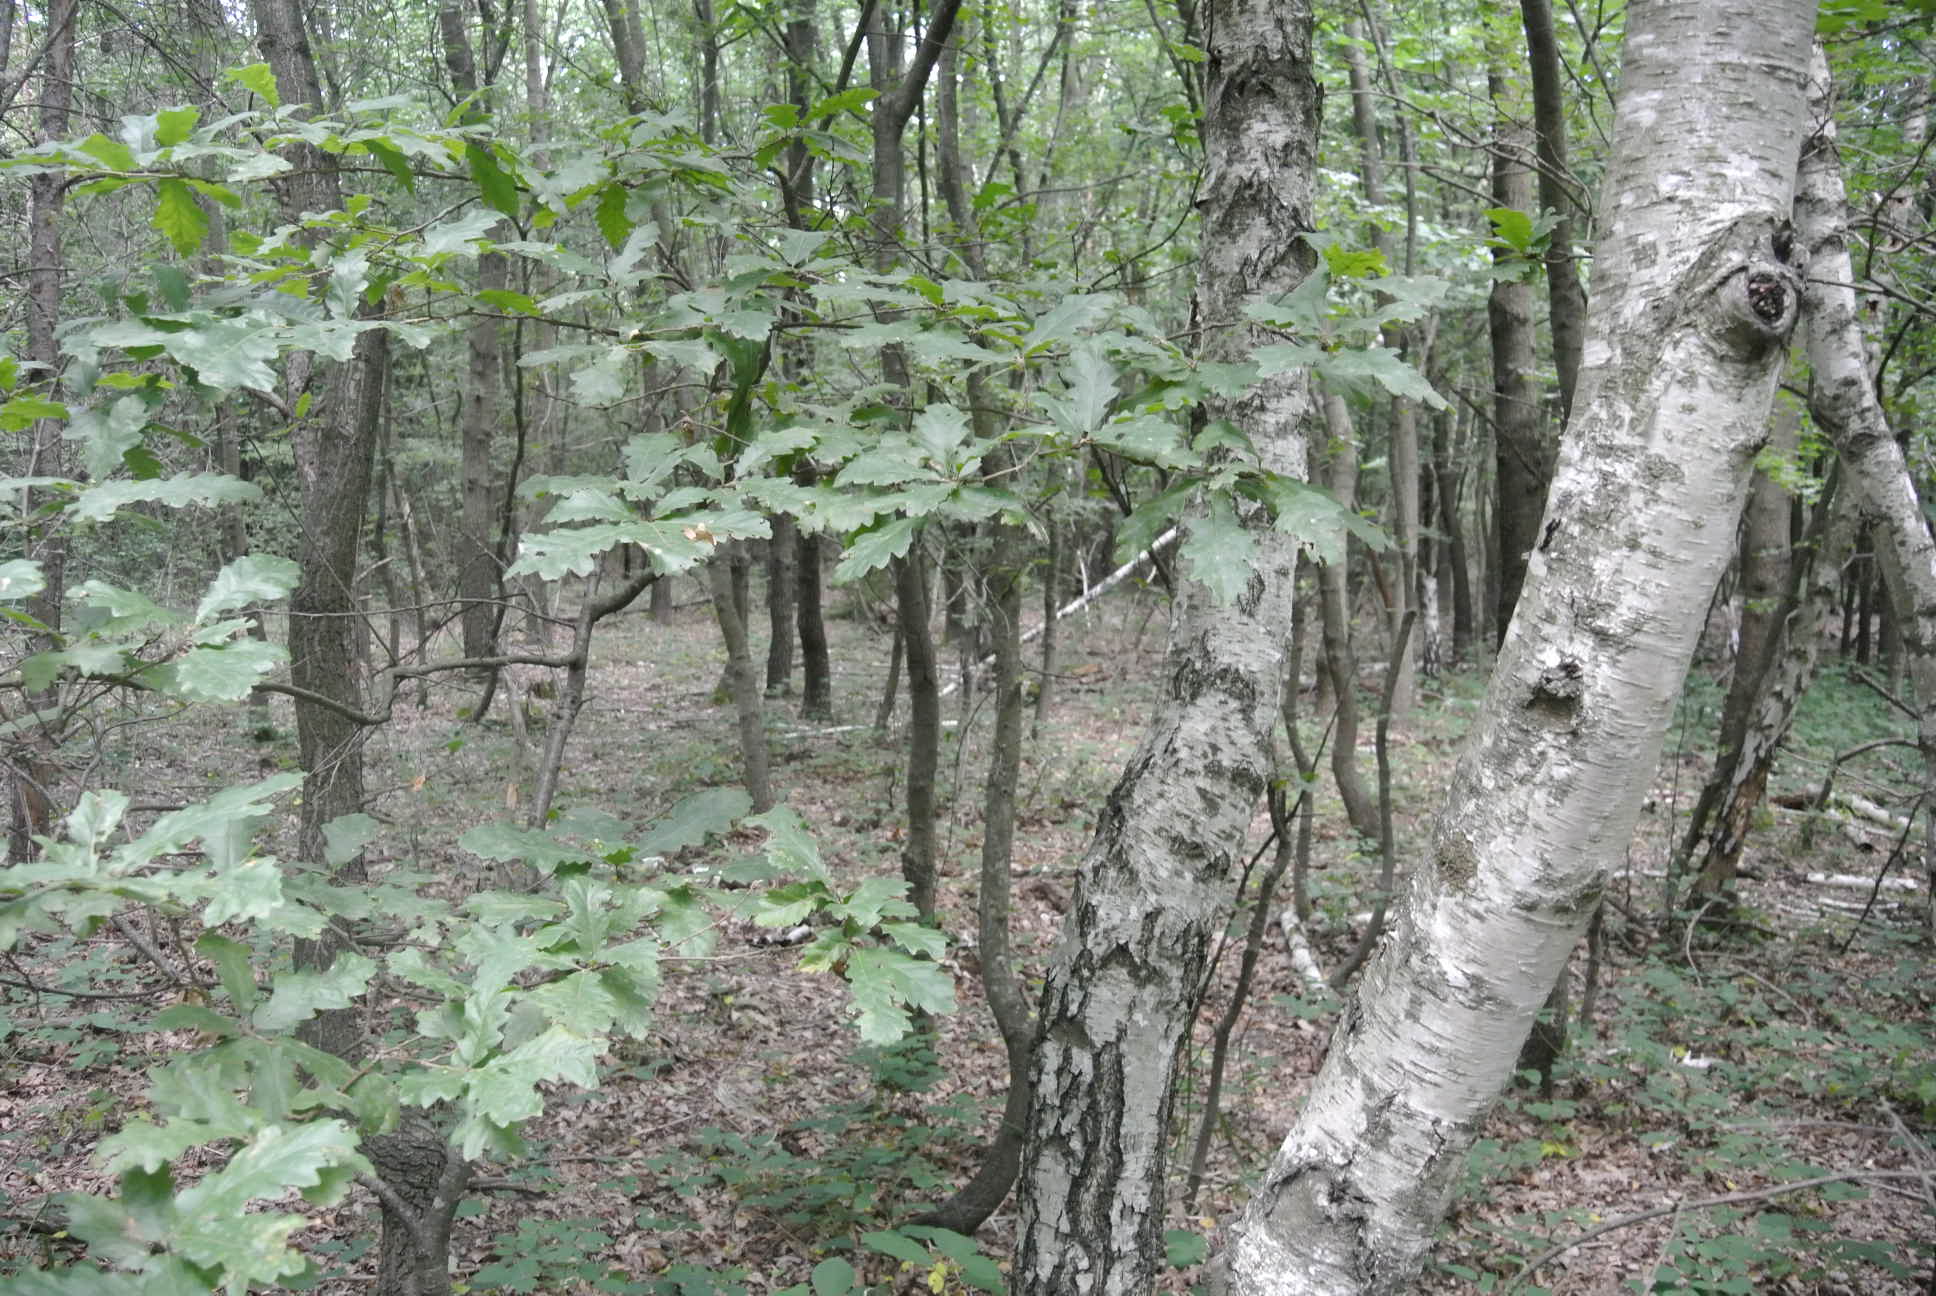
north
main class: Woodland
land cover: Broadleaved woodland
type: beech forest
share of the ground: > 75 %
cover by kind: broadleaved forest trees 100 %
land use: Forestry
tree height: > 5 m
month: July
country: AT
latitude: 47.7265
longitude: 16.4705
